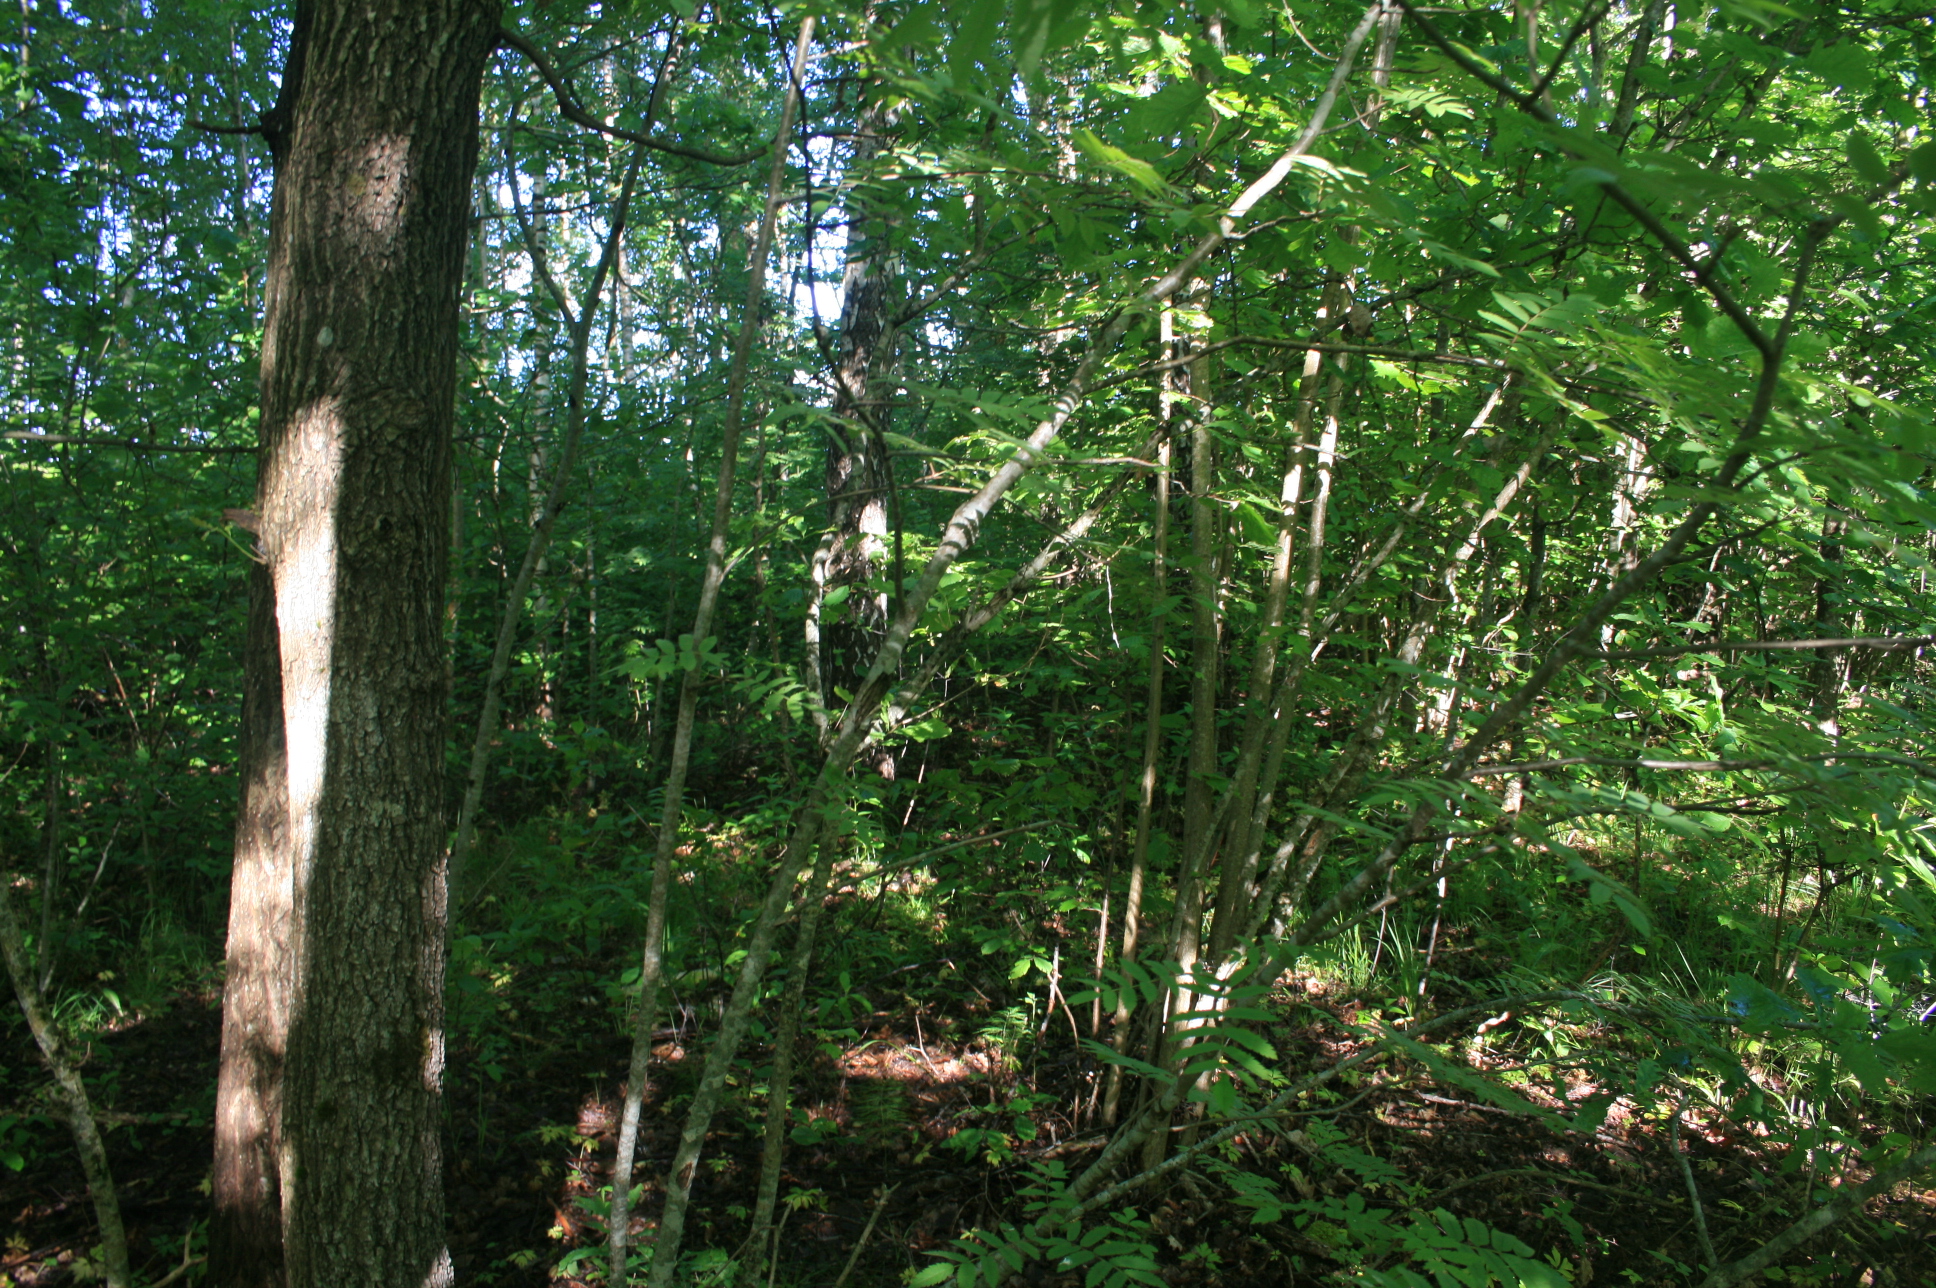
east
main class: Woodland
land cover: Broadleaved woodland
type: non-riverine alder, birch or aspen forest
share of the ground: > 75 %
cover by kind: broadleaved forest trees 95 %, herbaceous plants 5 %
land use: Forestry
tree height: > 5 m
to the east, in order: Broadleaved woodland; Grassland without tree/shrub cover; Spontaneously vegetated surfaces
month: June
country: LT
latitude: 55.5031
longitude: 22.1028
